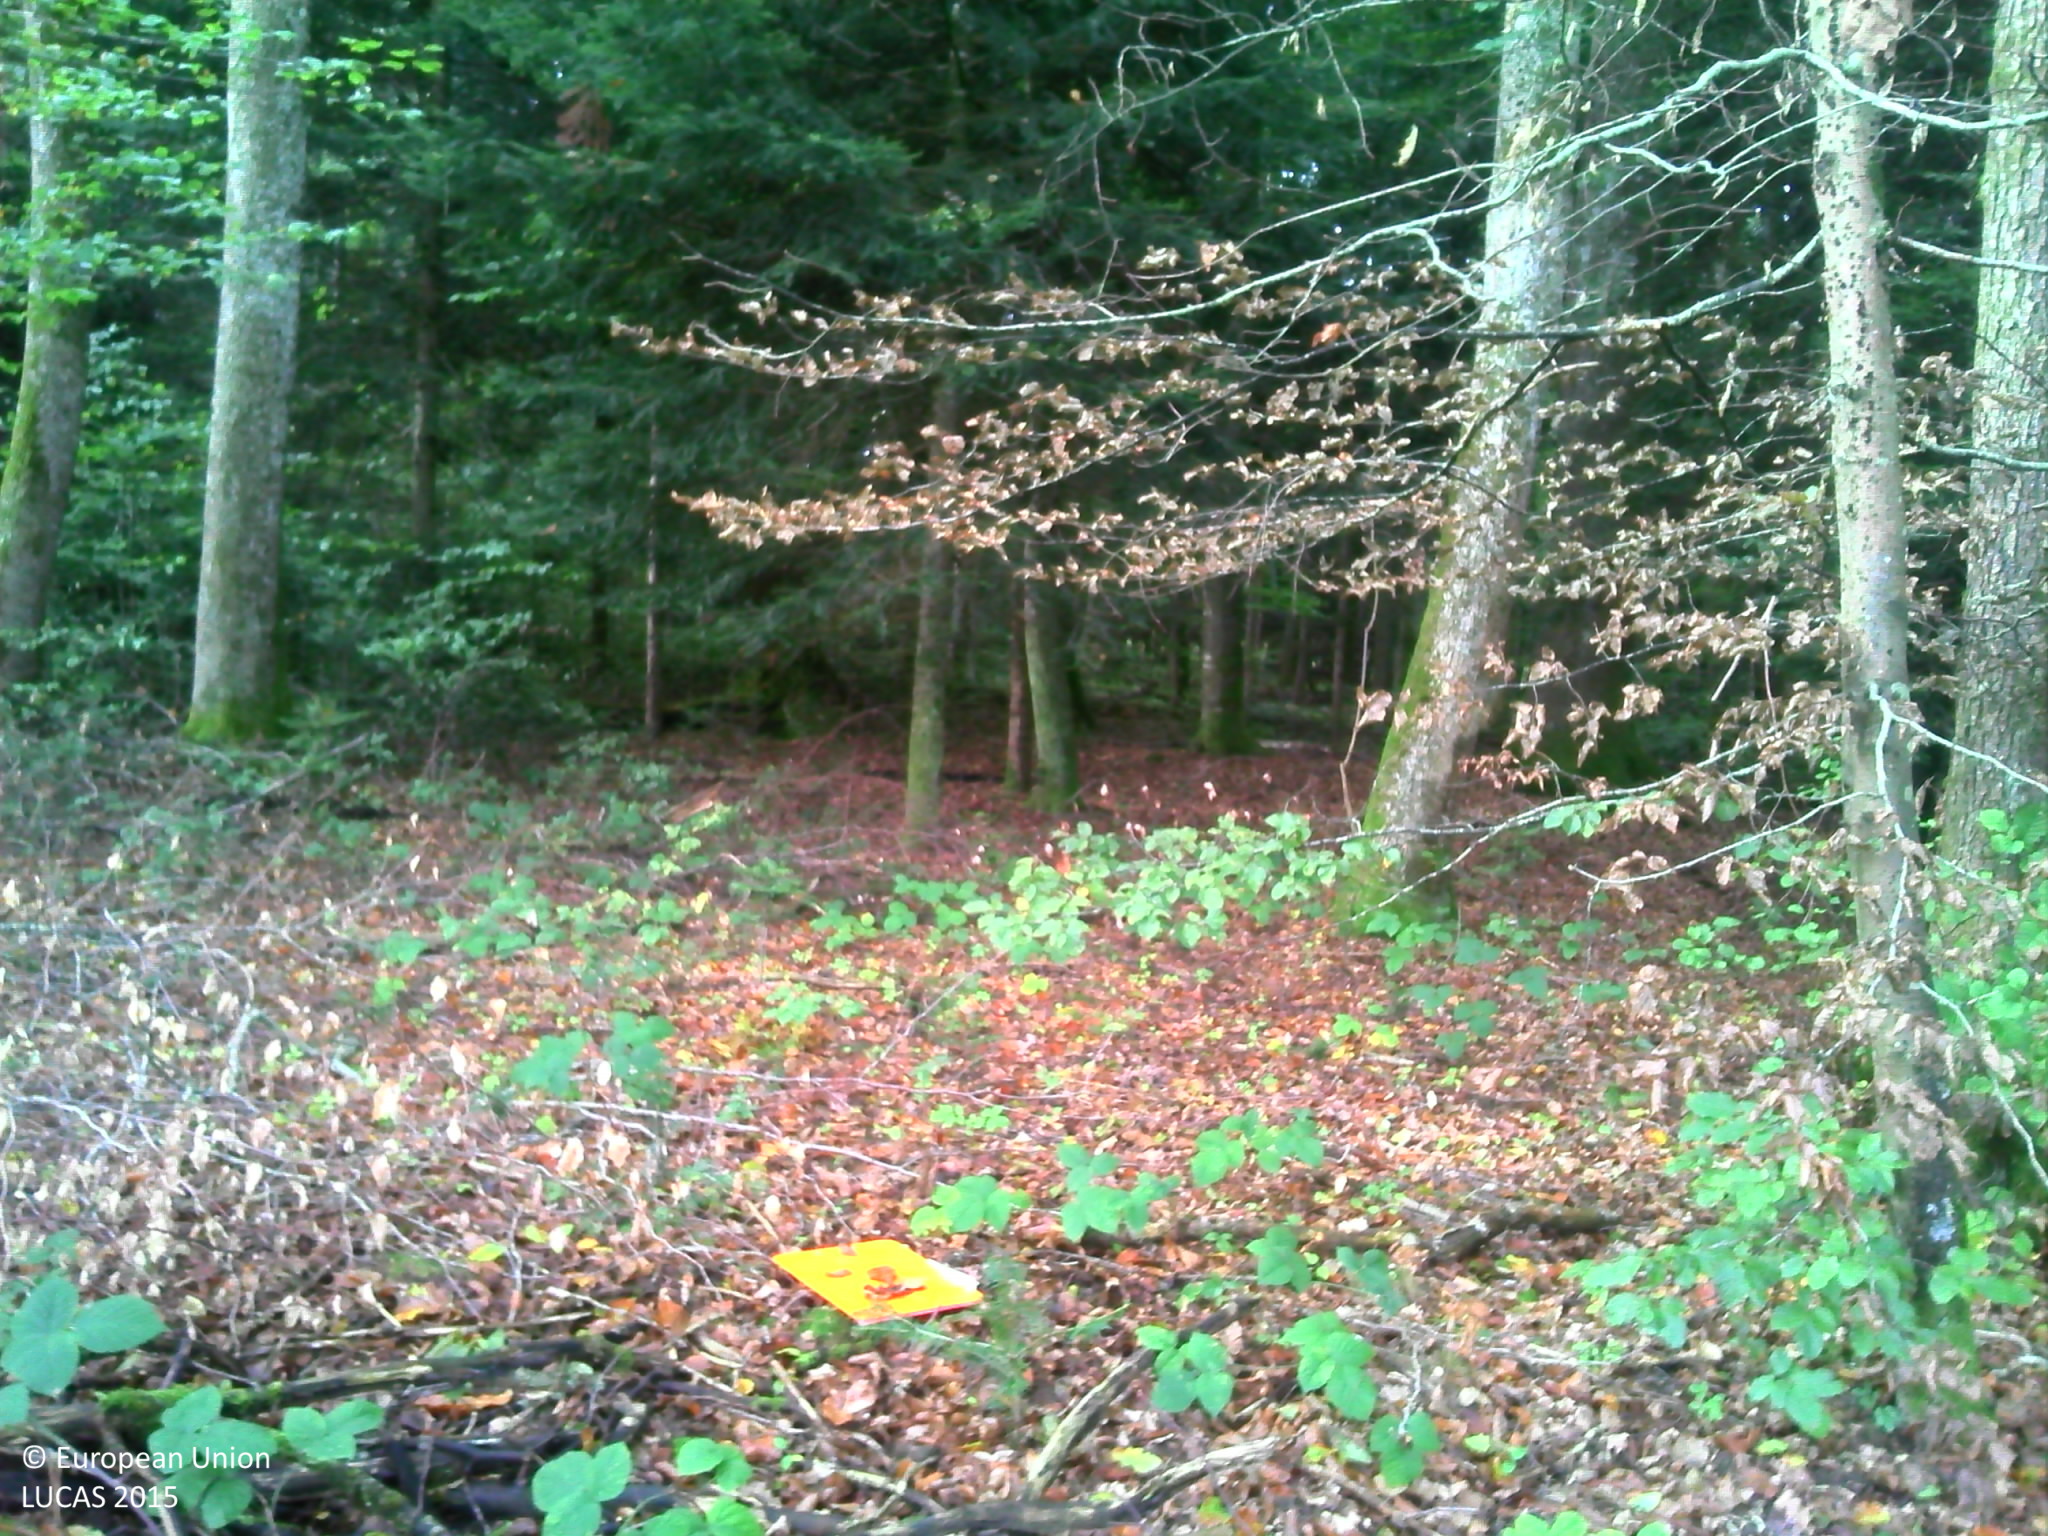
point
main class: Woodland
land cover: Other mixed woodland
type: hemiboreal forest and nemoral coniferous forest and mixed broadleaved-coniferous forest
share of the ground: > 75 %
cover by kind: broadleaved forest trees 45 %, coniferous forest trees 40 %, consolidated bare surface 10 %, herbaceous plants 5 %
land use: Forestry
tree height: > 5 m
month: September
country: FR
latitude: 48.4659
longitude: 6.8224
